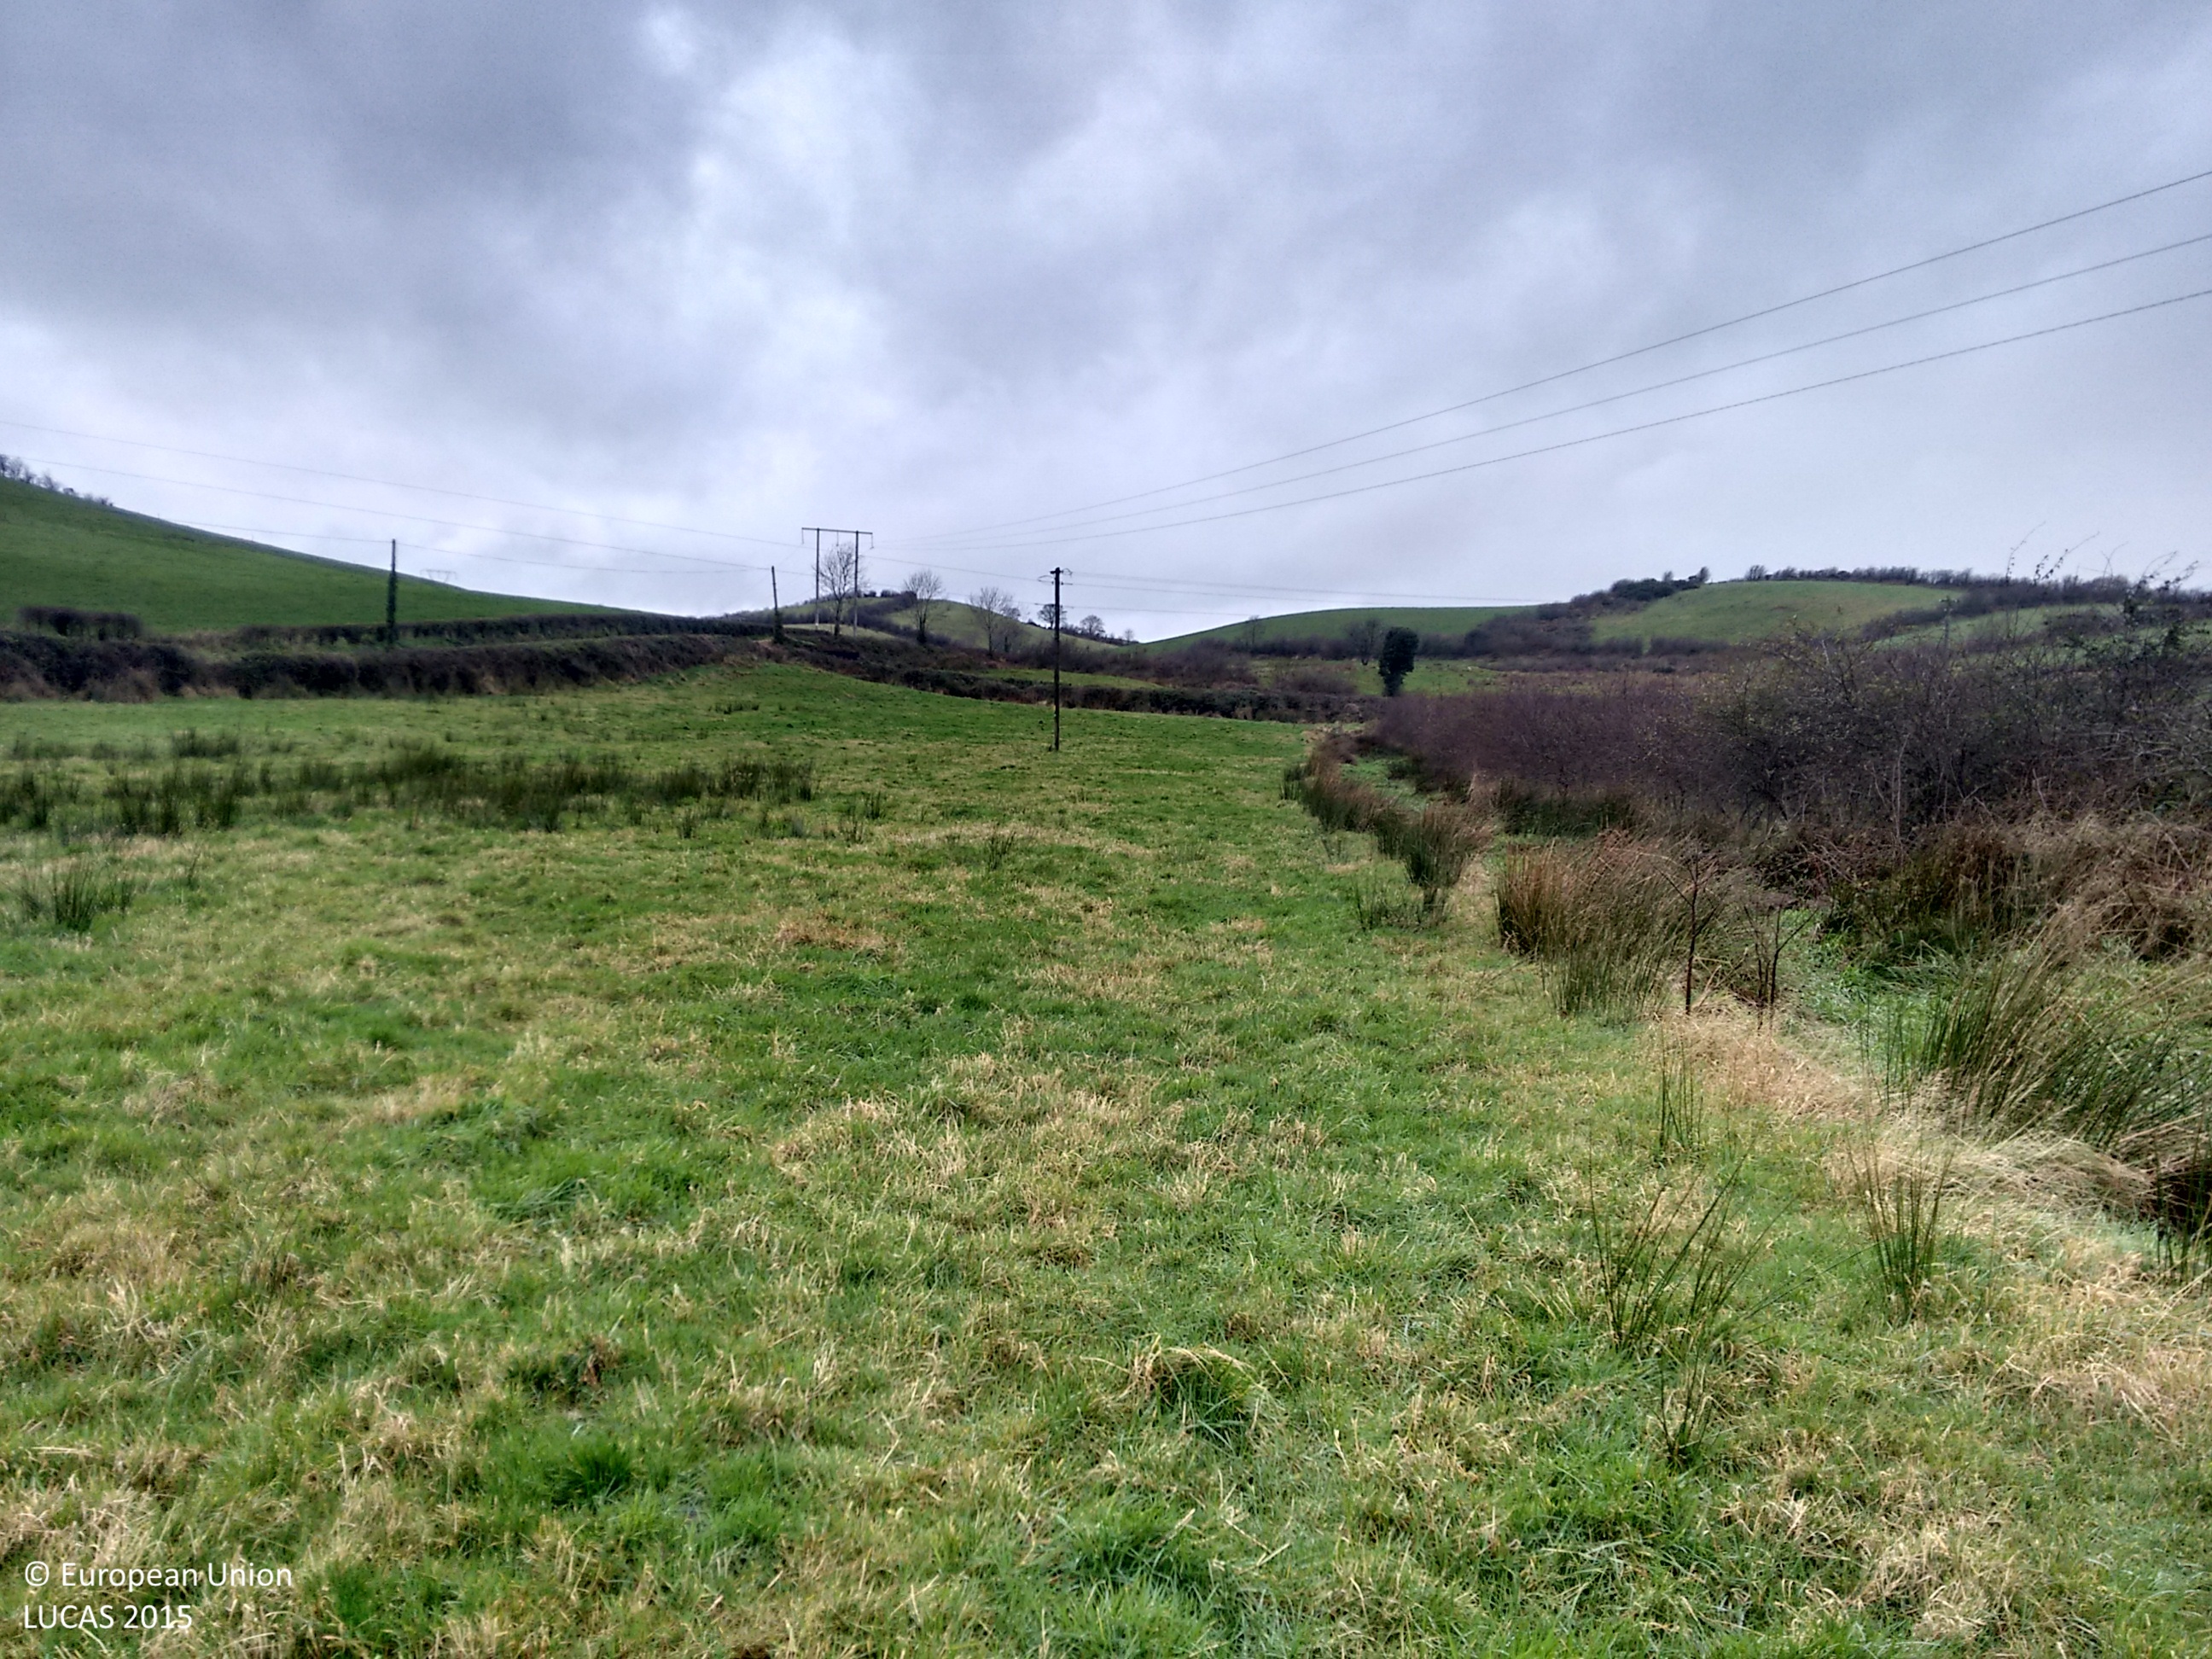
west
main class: Grassland
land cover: Grassland without tree/shrub cover
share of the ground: > 75 %
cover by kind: herbaceous plants 100 %
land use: Agriculture (excluding fallow land and kitchen gardens)
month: December
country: IE
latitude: 54.0212
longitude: -6.9126
